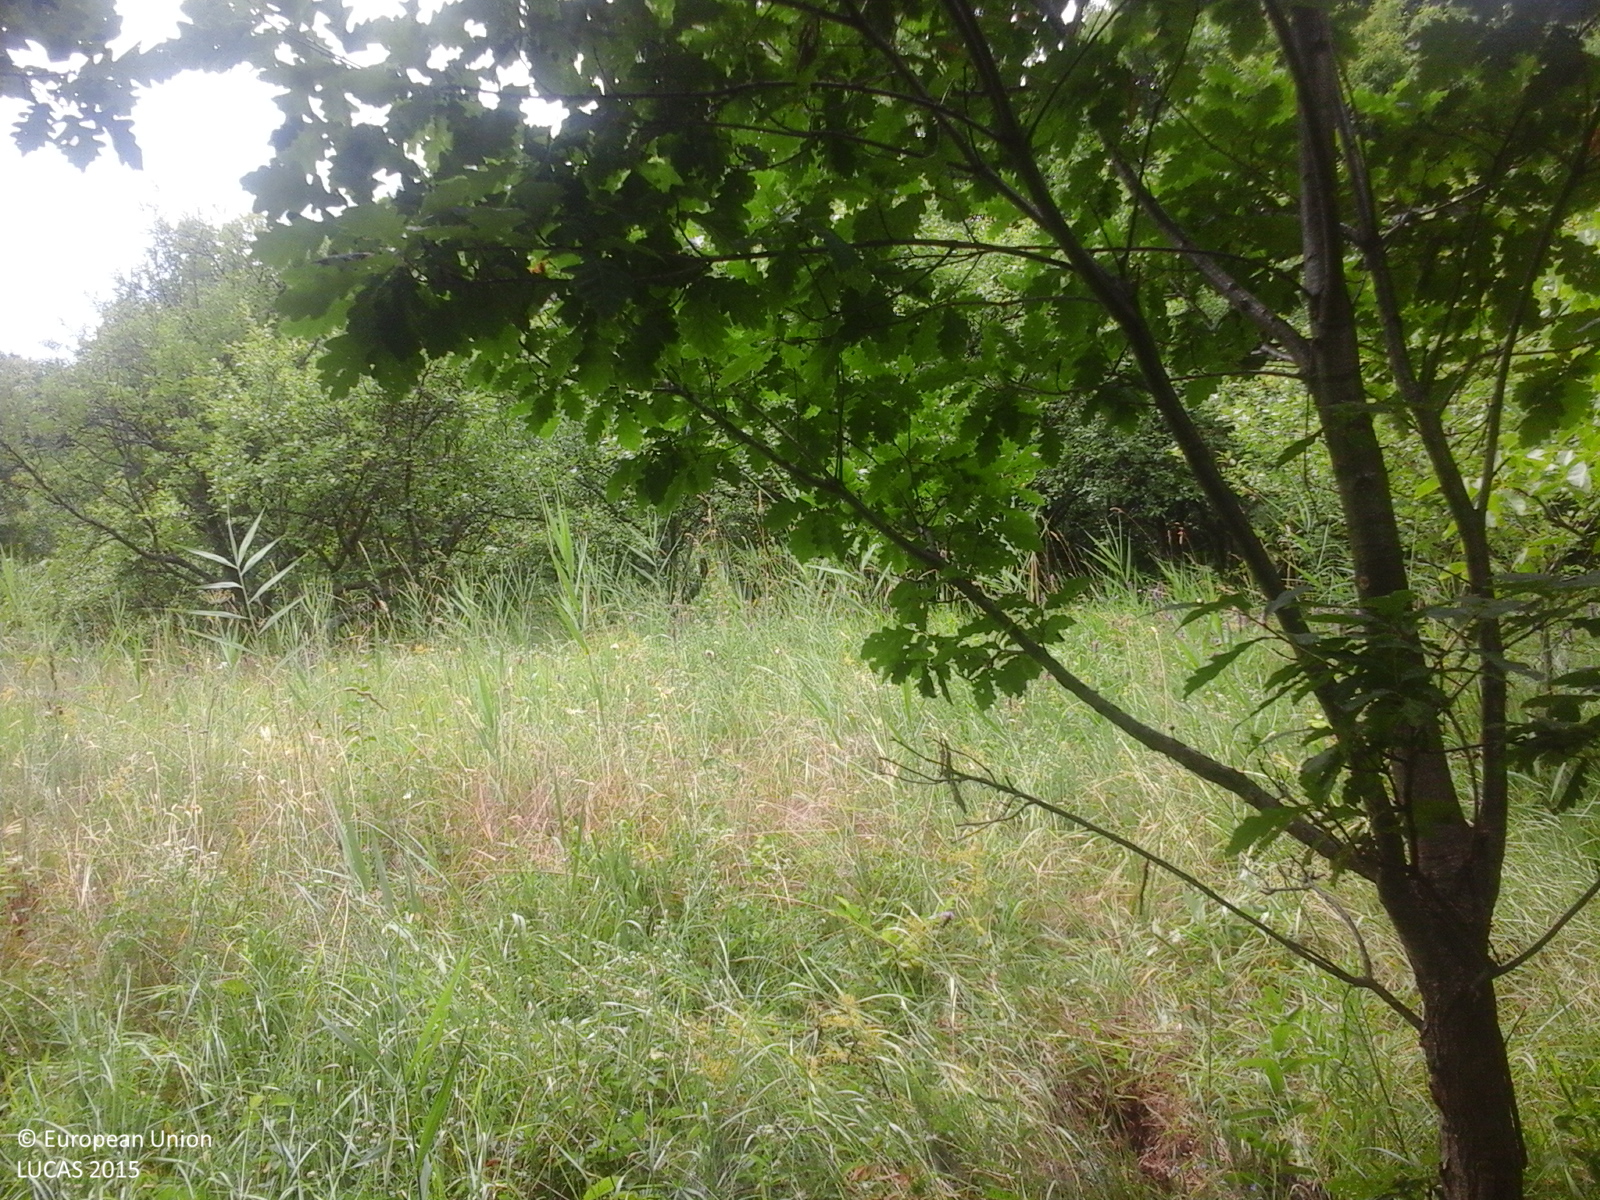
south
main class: Woodland
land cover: Broadleaved woodland
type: beech forest
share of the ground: > 75 %
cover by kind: broadleaved forest trees 100 %
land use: Forestry
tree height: > 5 m
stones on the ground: < 10 %
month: July
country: RO
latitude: 45.1889
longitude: 24.6533
